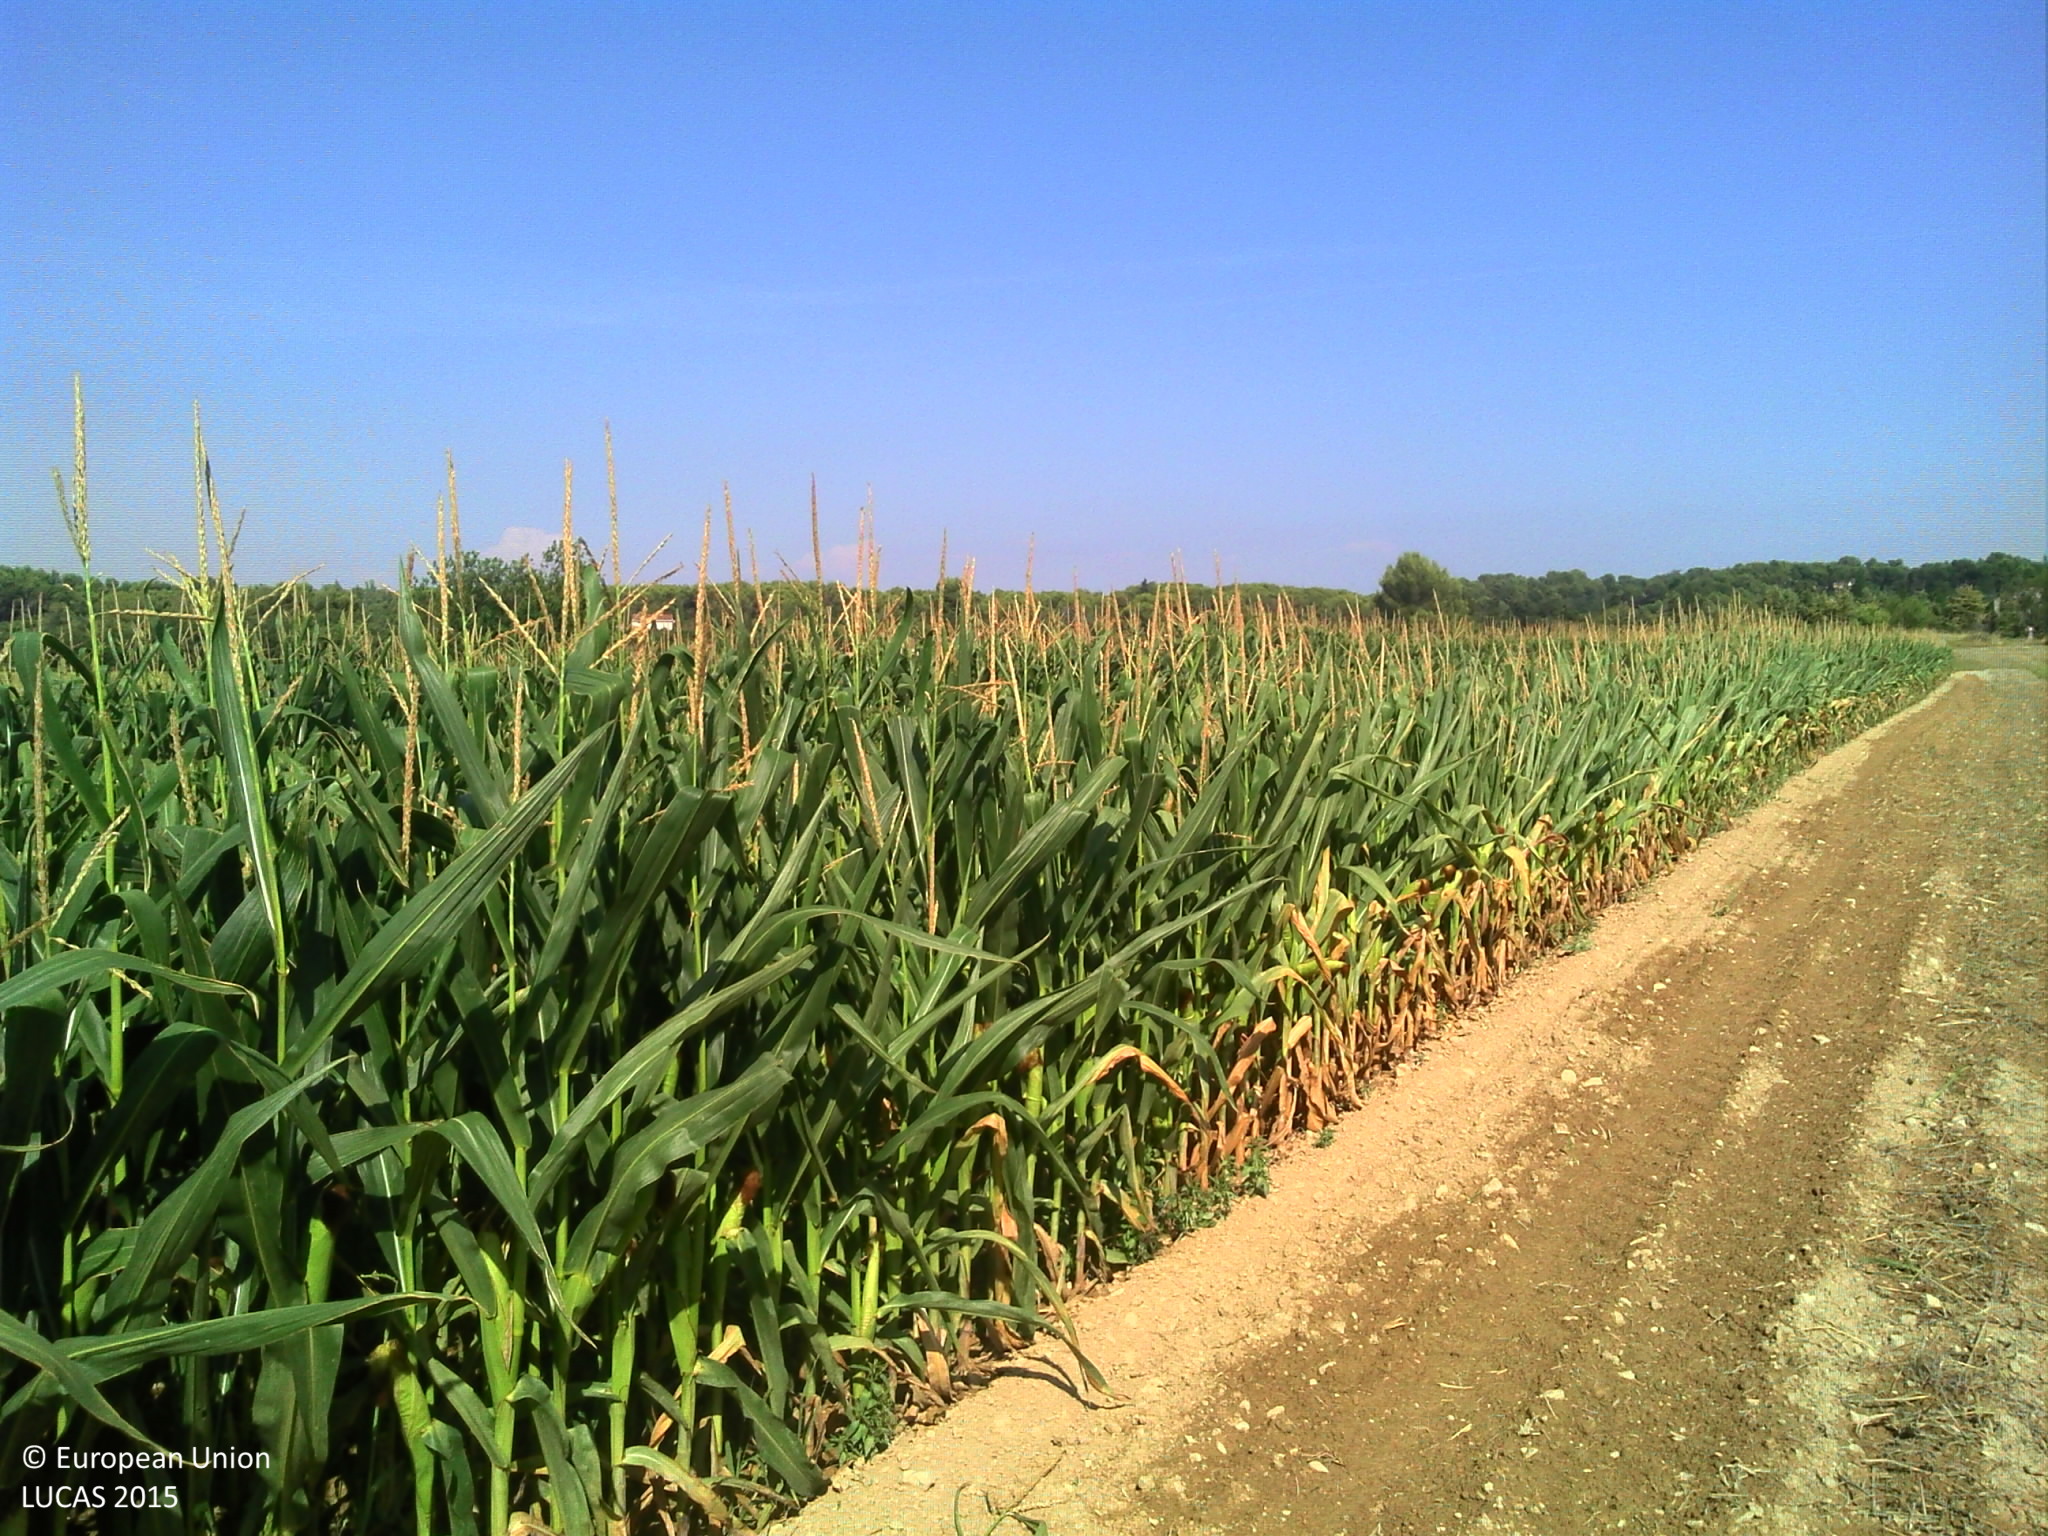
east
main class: Cropland
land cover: Maize
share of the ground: > 75 %
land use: Agriculture (excluding fallow land and kitchen gardens)
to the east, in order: Maize; Spontaneously vegetated surfaces; Grass margins; Ditches and canals; Grass margins; Paved roads, cycling and walking lanes; Grass margins; Durum wheat
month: August
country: FR
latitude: 43.5774
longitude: 5.3411
